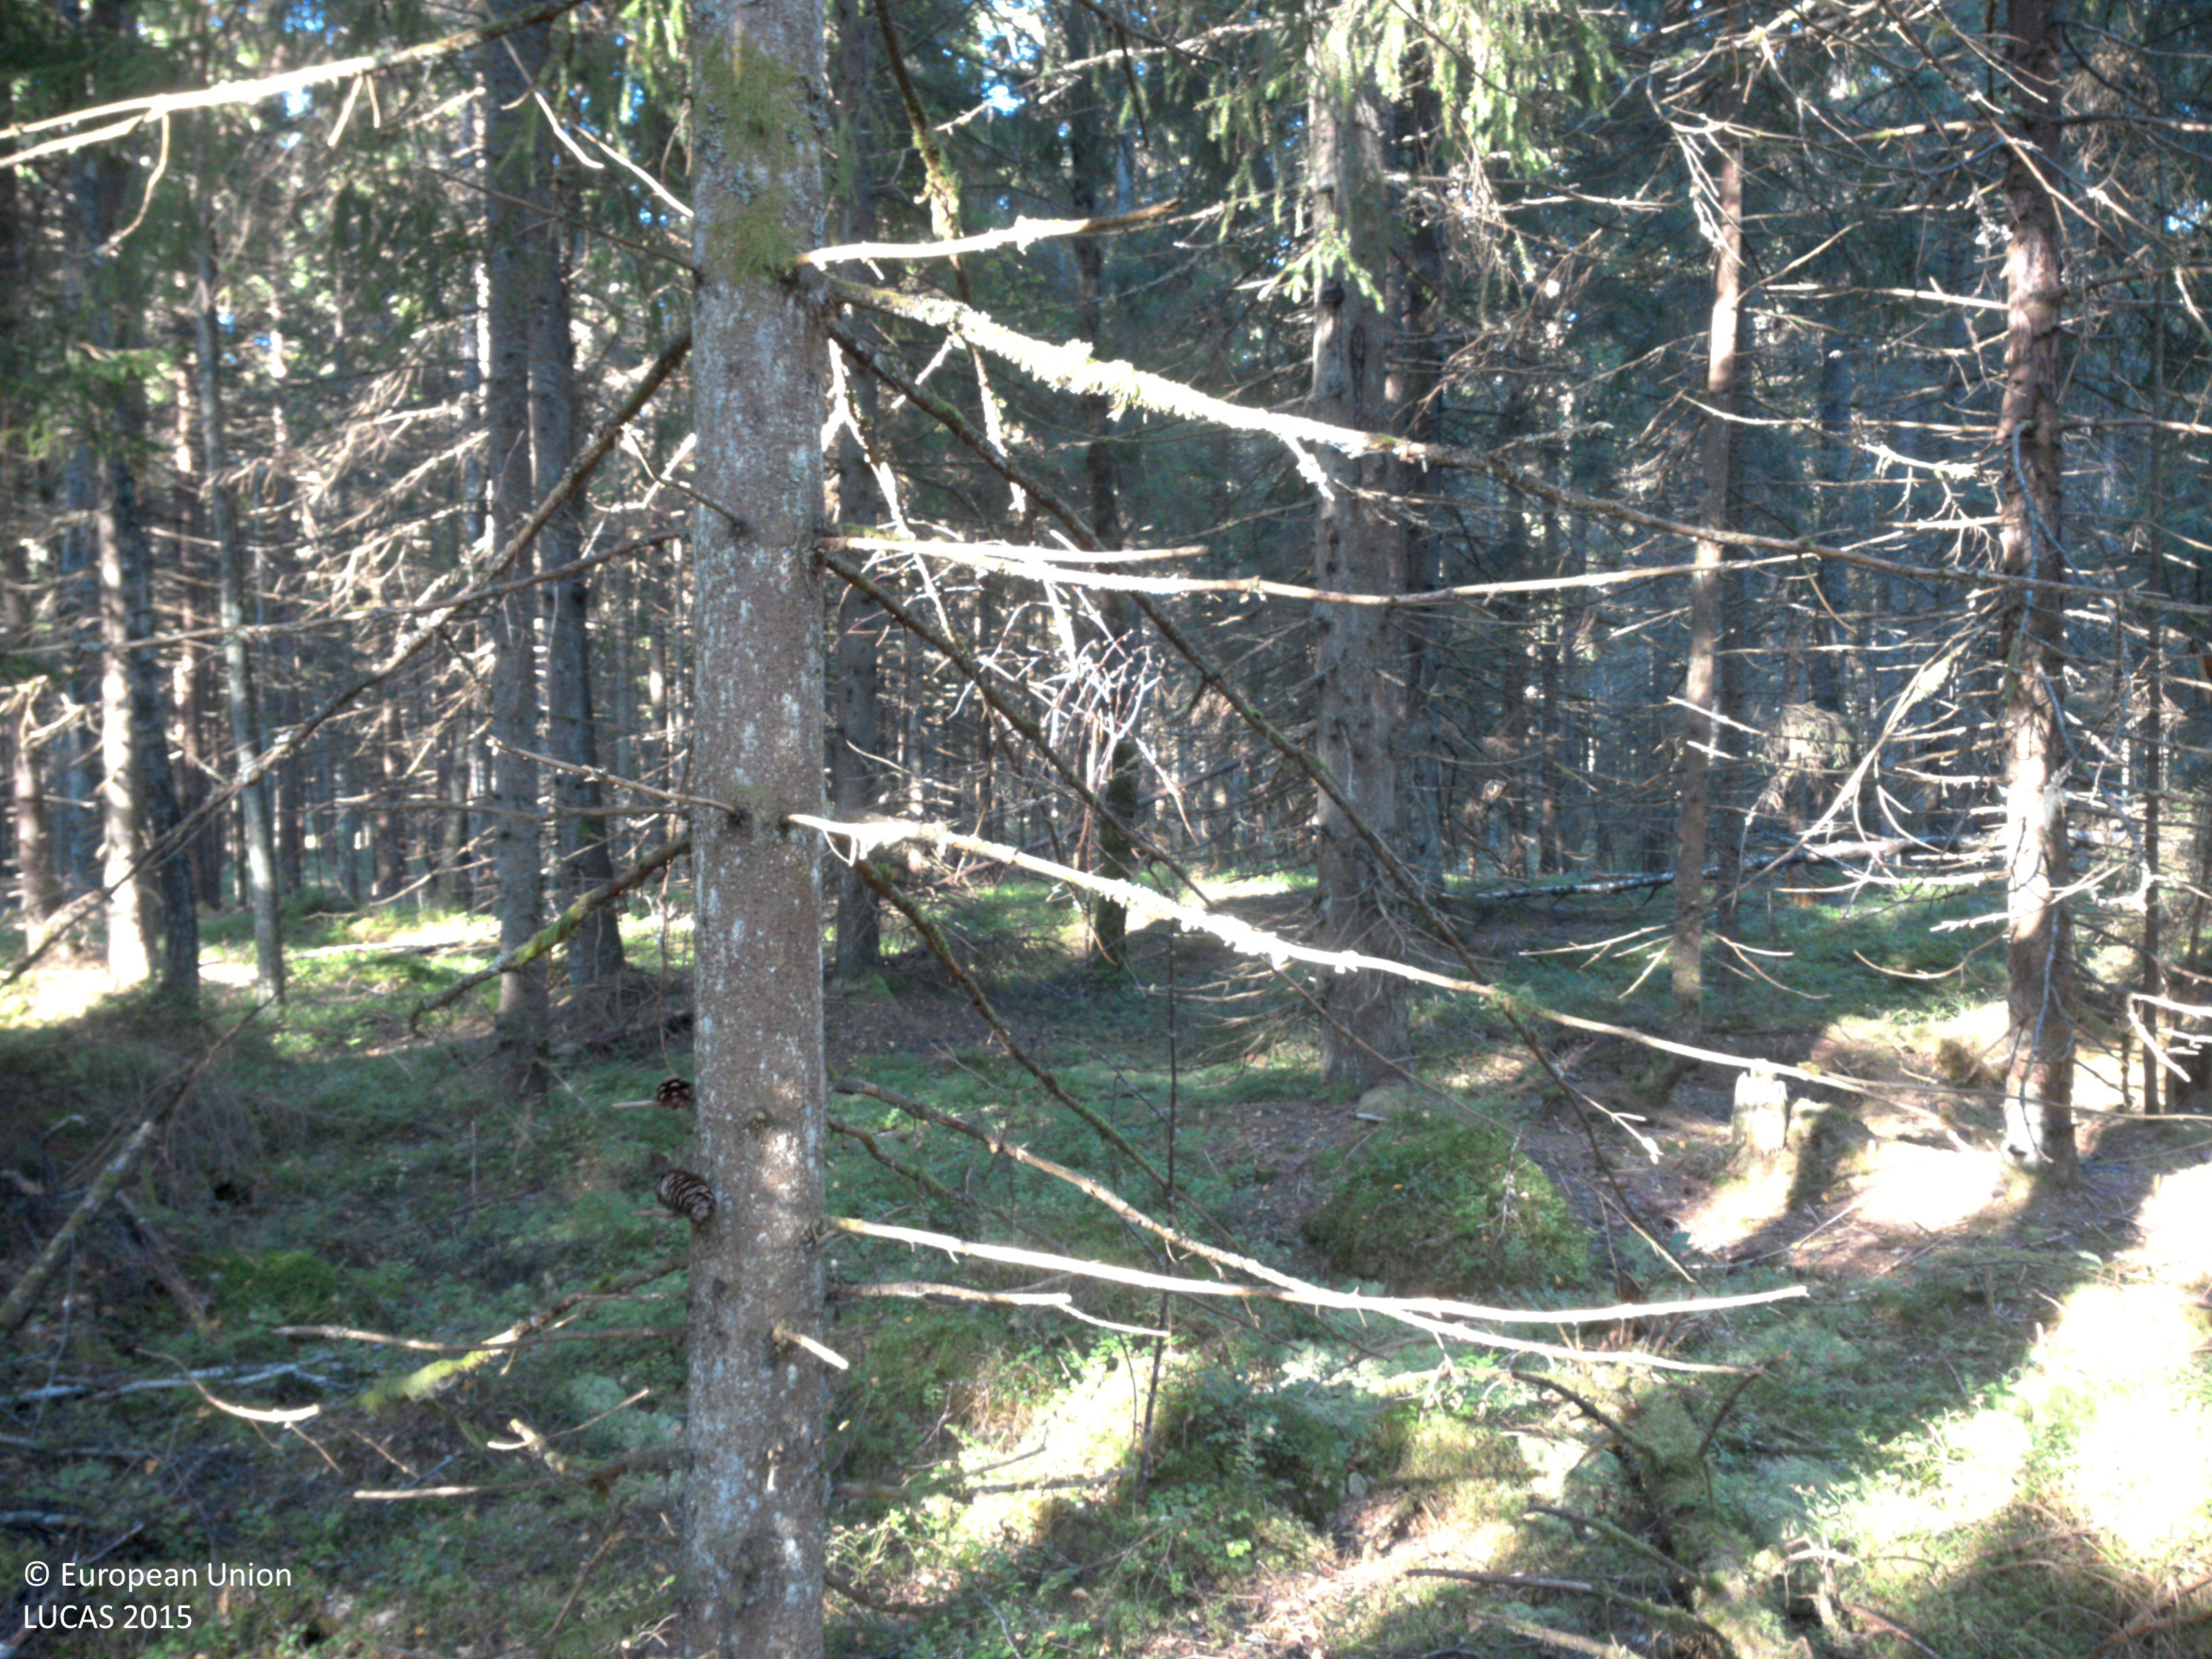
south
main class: Woodland
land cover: Spruce dominated coniferous woodland
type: boreal forest
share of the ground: 50 - 75 %
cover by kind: coniferous forest trees 60 %, shrubs 15 %, lichens and mosses 15 %, herbaceous plants 10 %
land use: Forestry
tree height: > 5 m
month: August
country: SE
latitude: 58.5426
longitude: 12.2460
